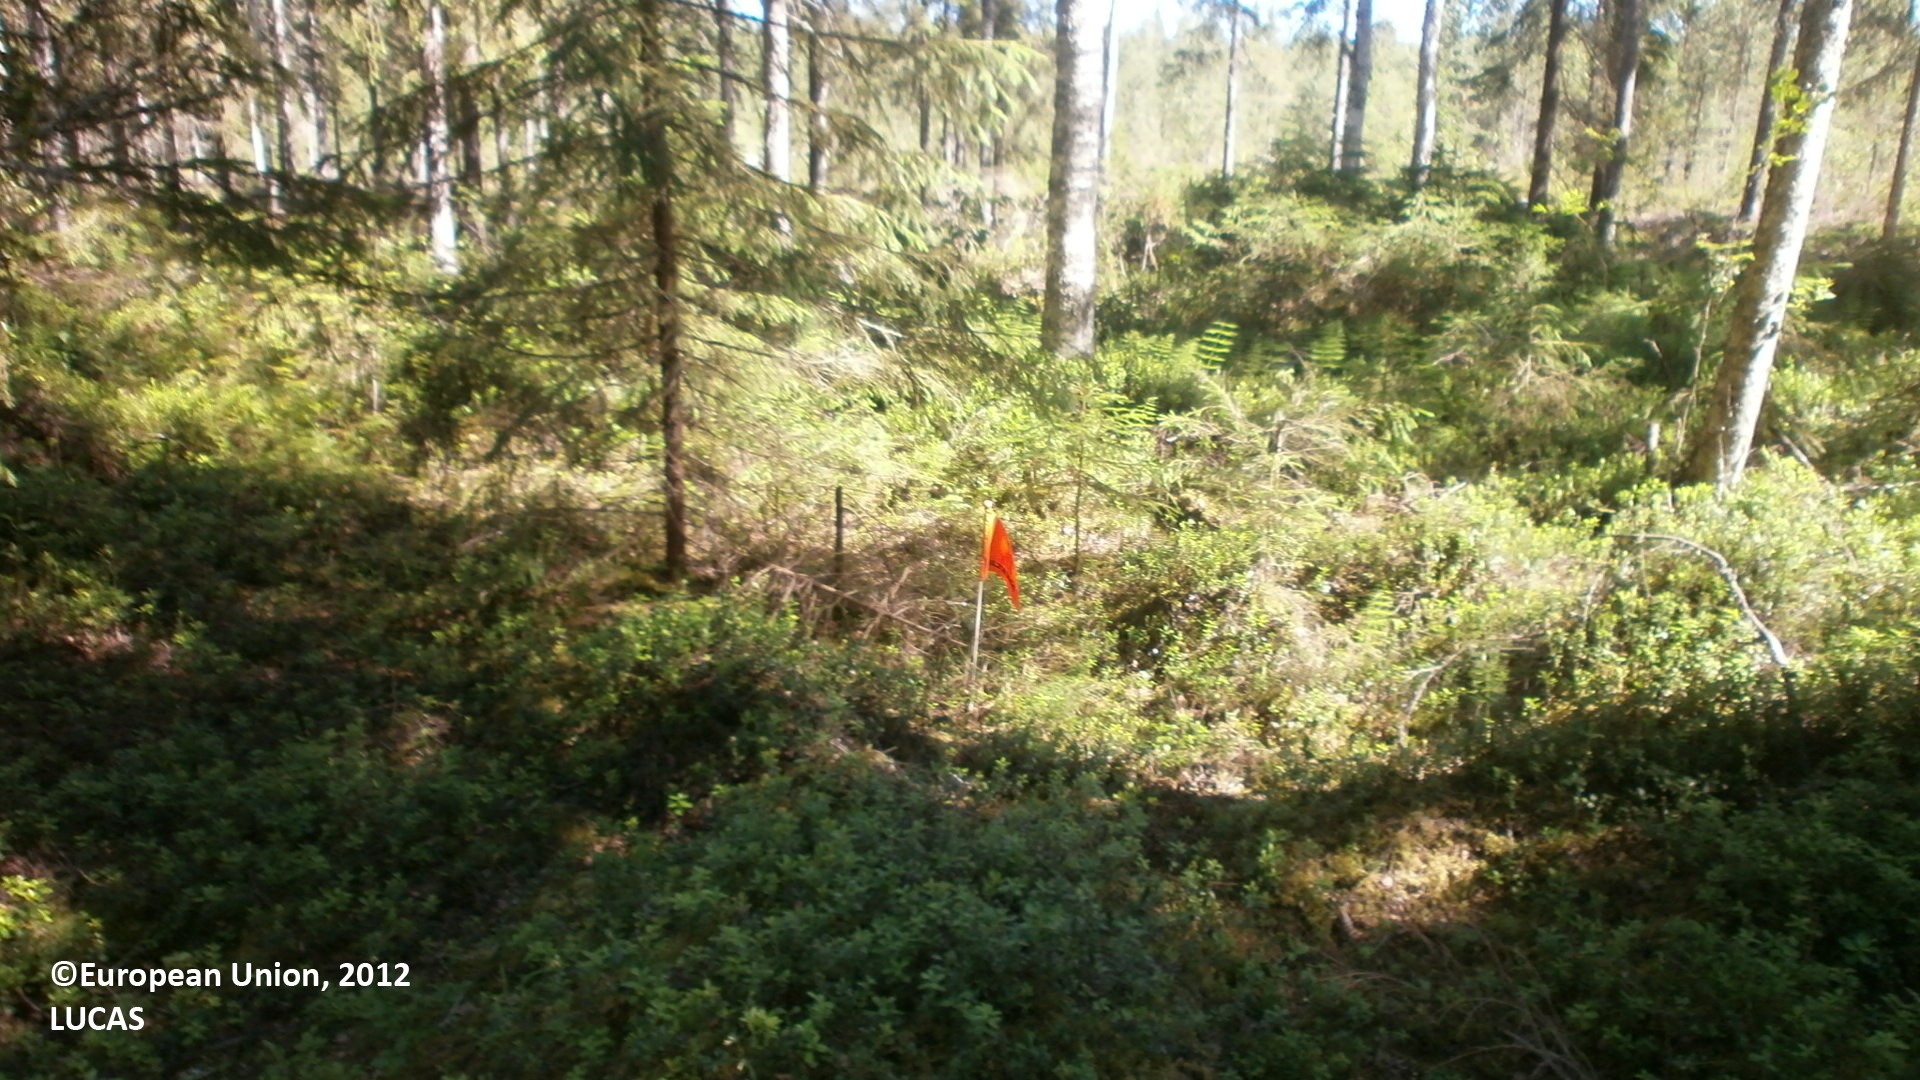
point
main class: Woodland
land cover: Spruce dominated coniferous woodland
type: boreal forest
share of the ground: 50 - 75 %
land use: Forestry
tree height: > 5 m
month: July
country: FI
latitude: 64.3515
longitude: 24.1234
